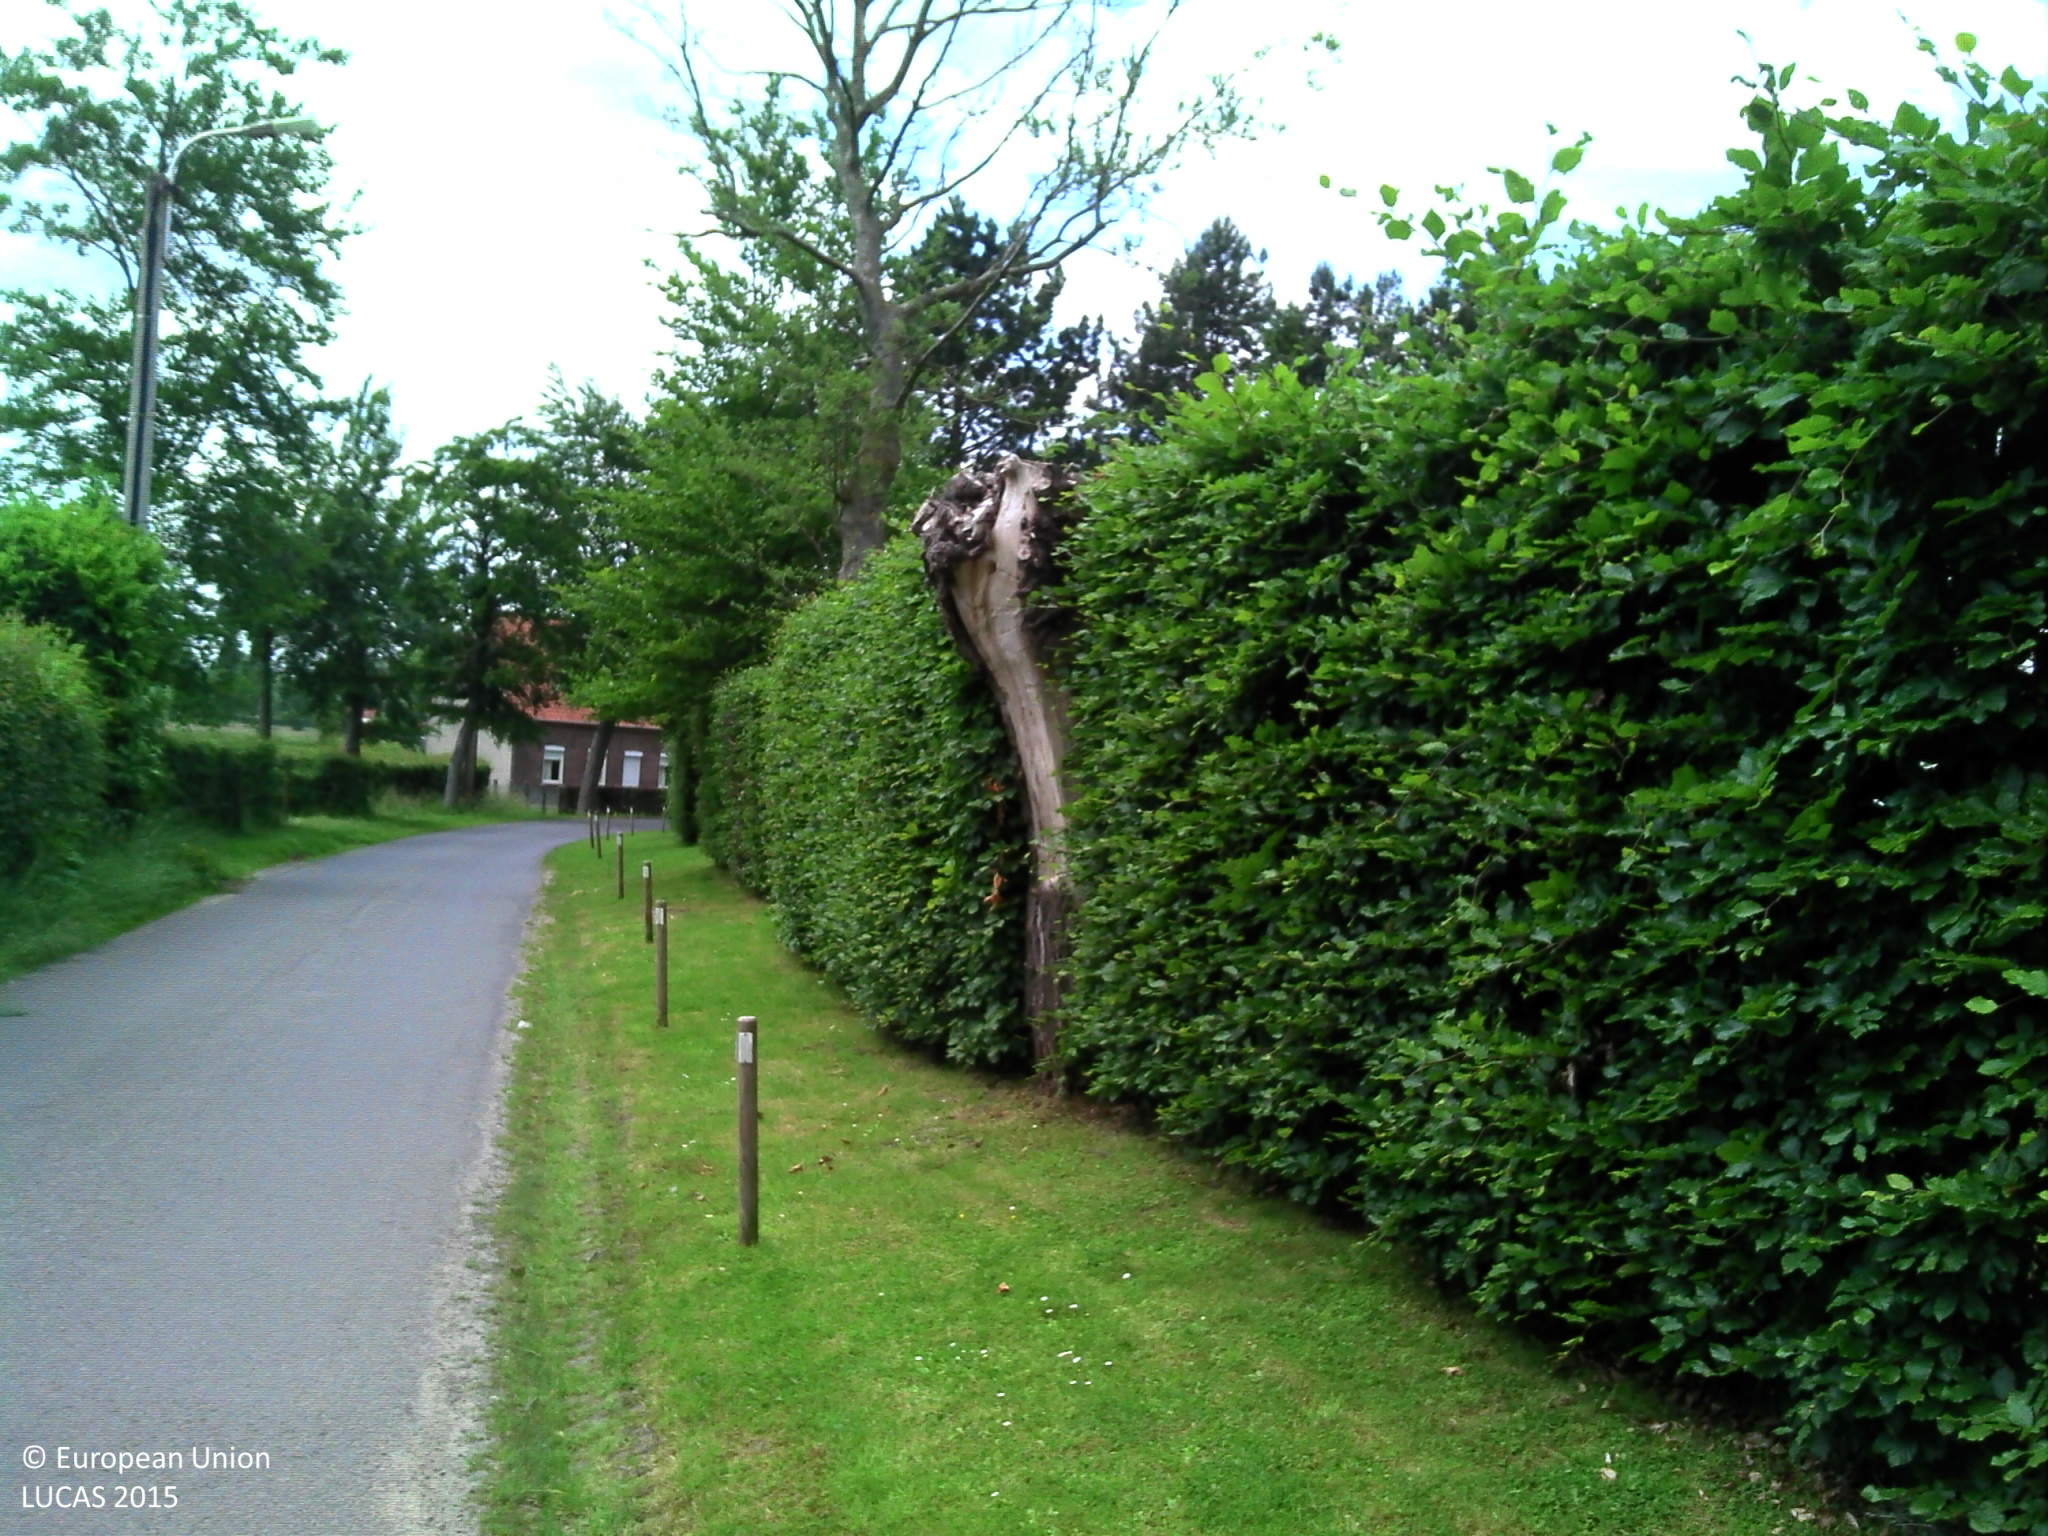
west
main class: Grassland
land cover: Grassland without tree/shrub cover
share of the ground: > 75 %
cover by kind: herbaceous plants 100 %
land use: Residential
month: June
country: BE
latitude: 50.8825
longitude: 3.4965
